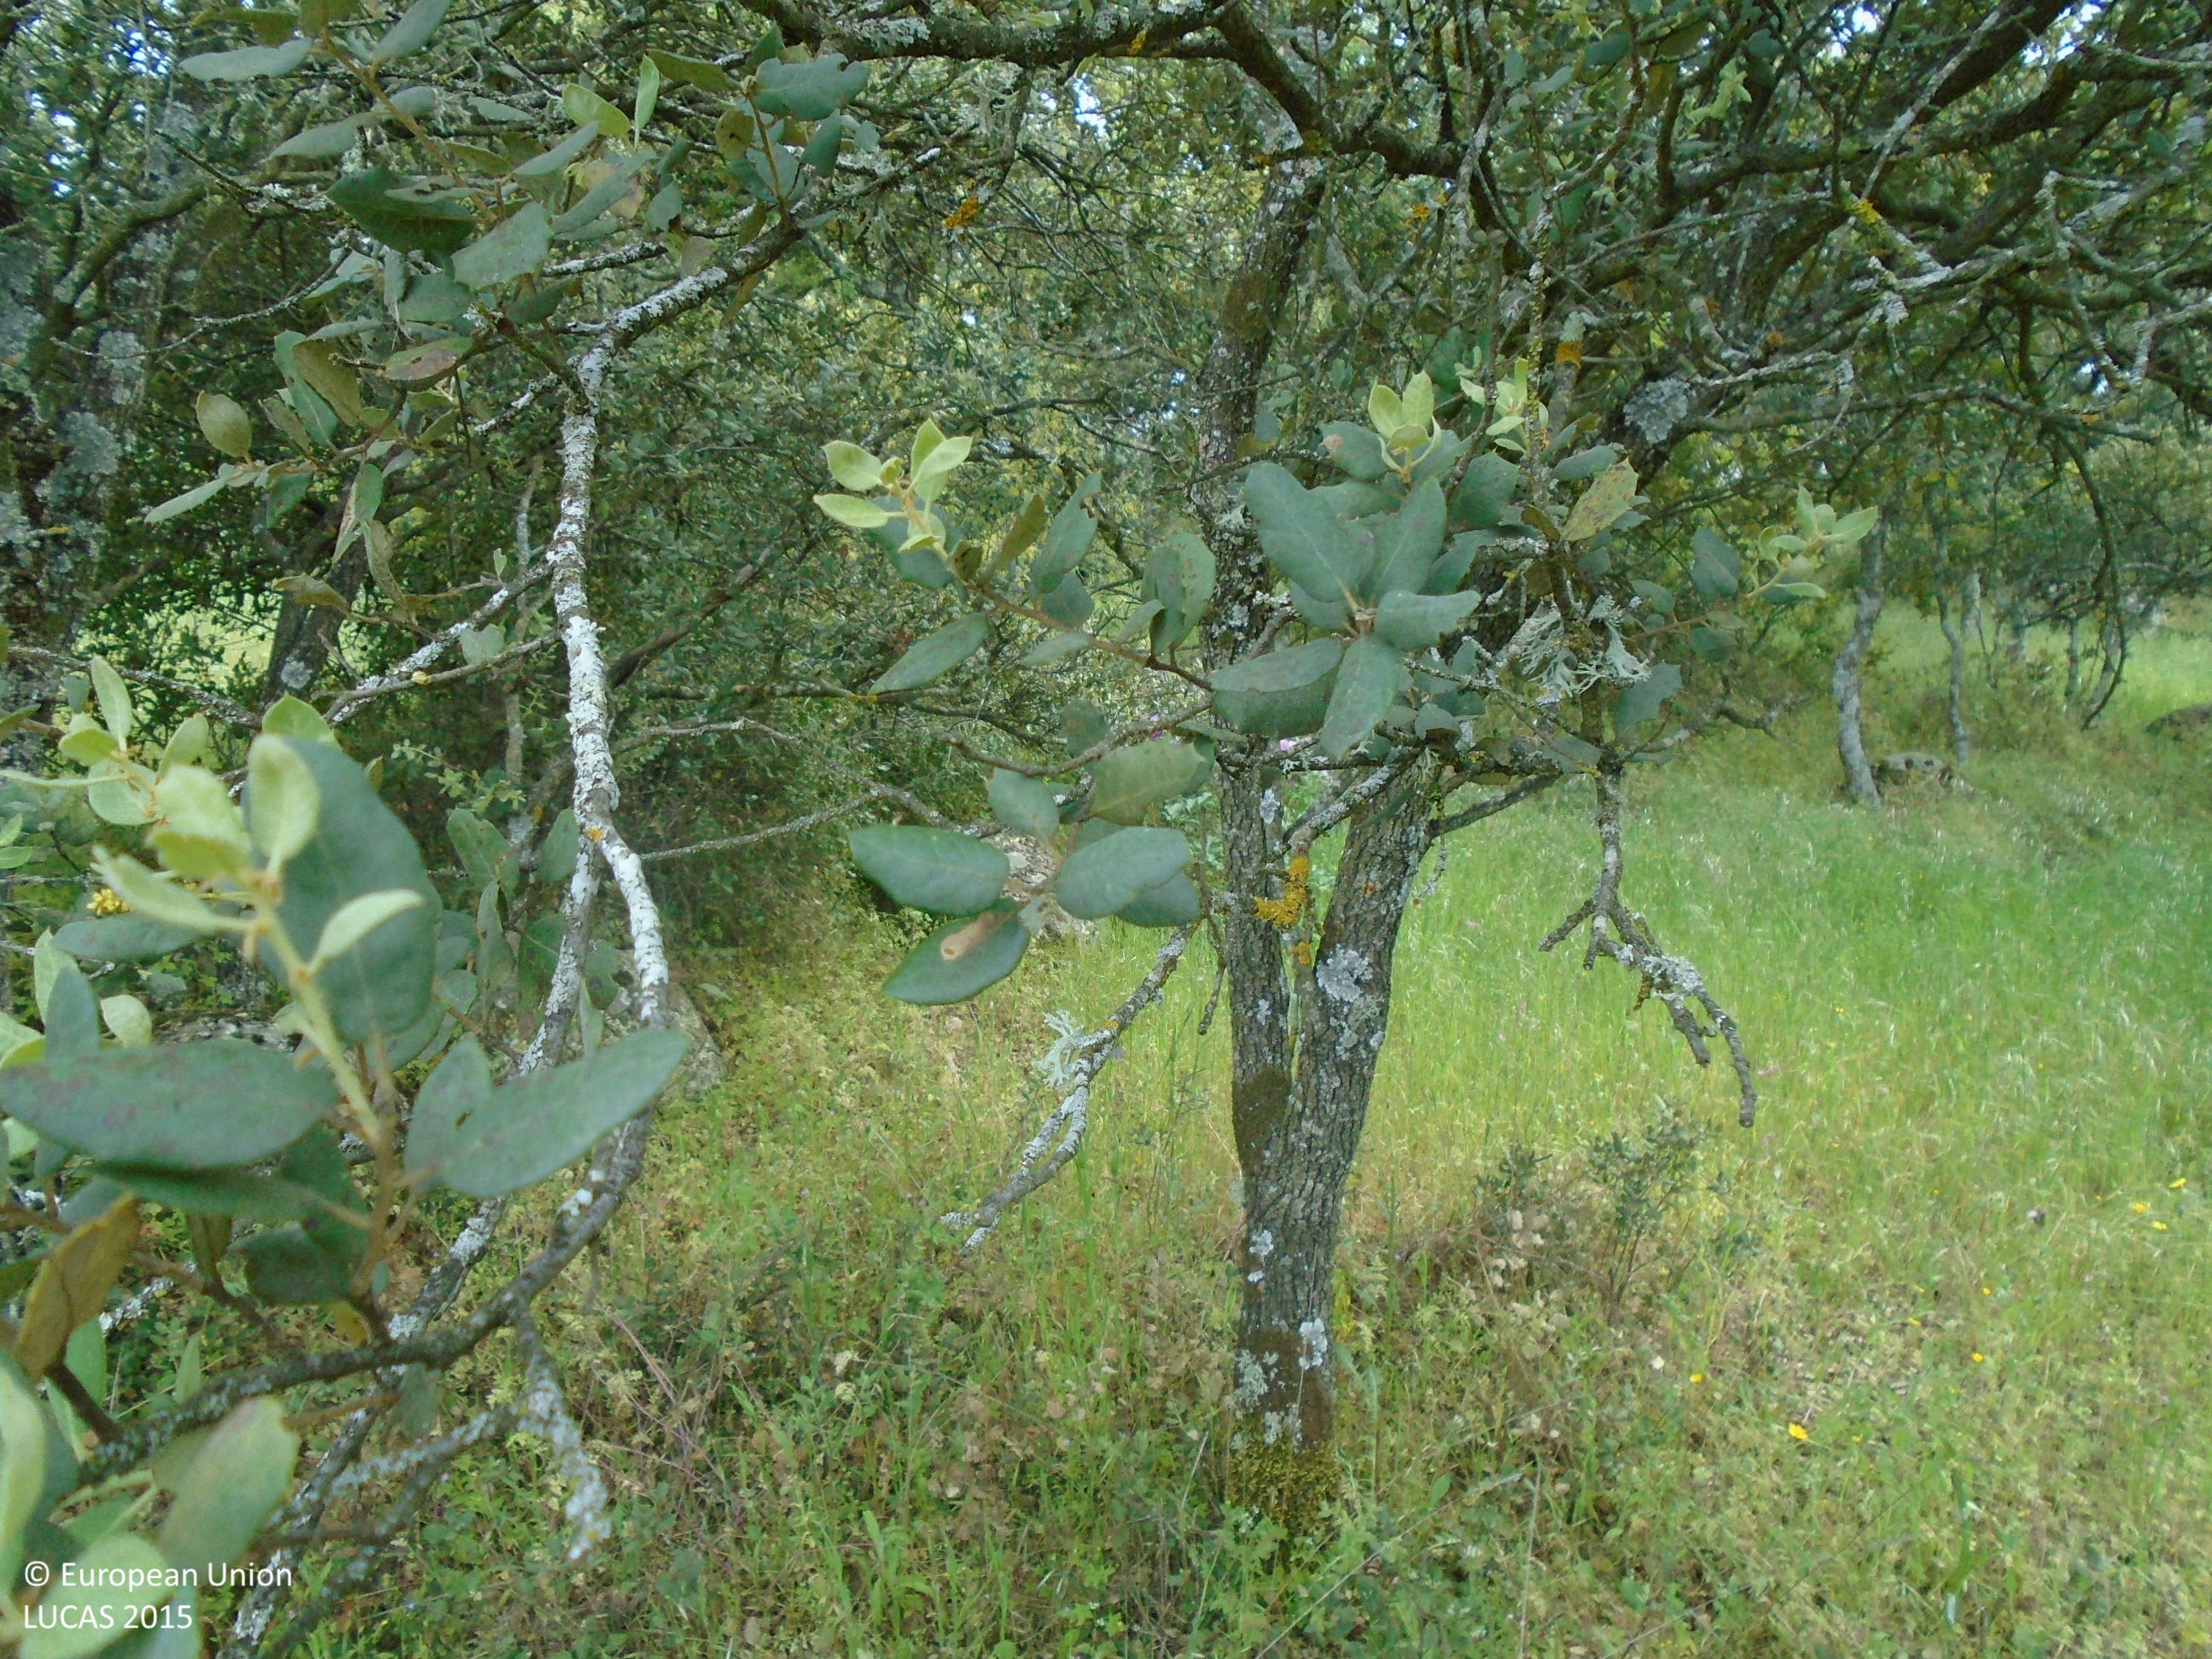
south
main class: Woodland
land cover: Broadleaved woodland
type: broadleaved evergreen forest
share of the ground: > 75 %
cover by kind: broadleaved forest trees 90 %, shrubs 5 %, herbaceous plants 5 %
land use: Semi-natural and natural areas not in use
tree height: > 5 m
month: May
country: ES
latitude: 39.7568
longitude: -4.7146
